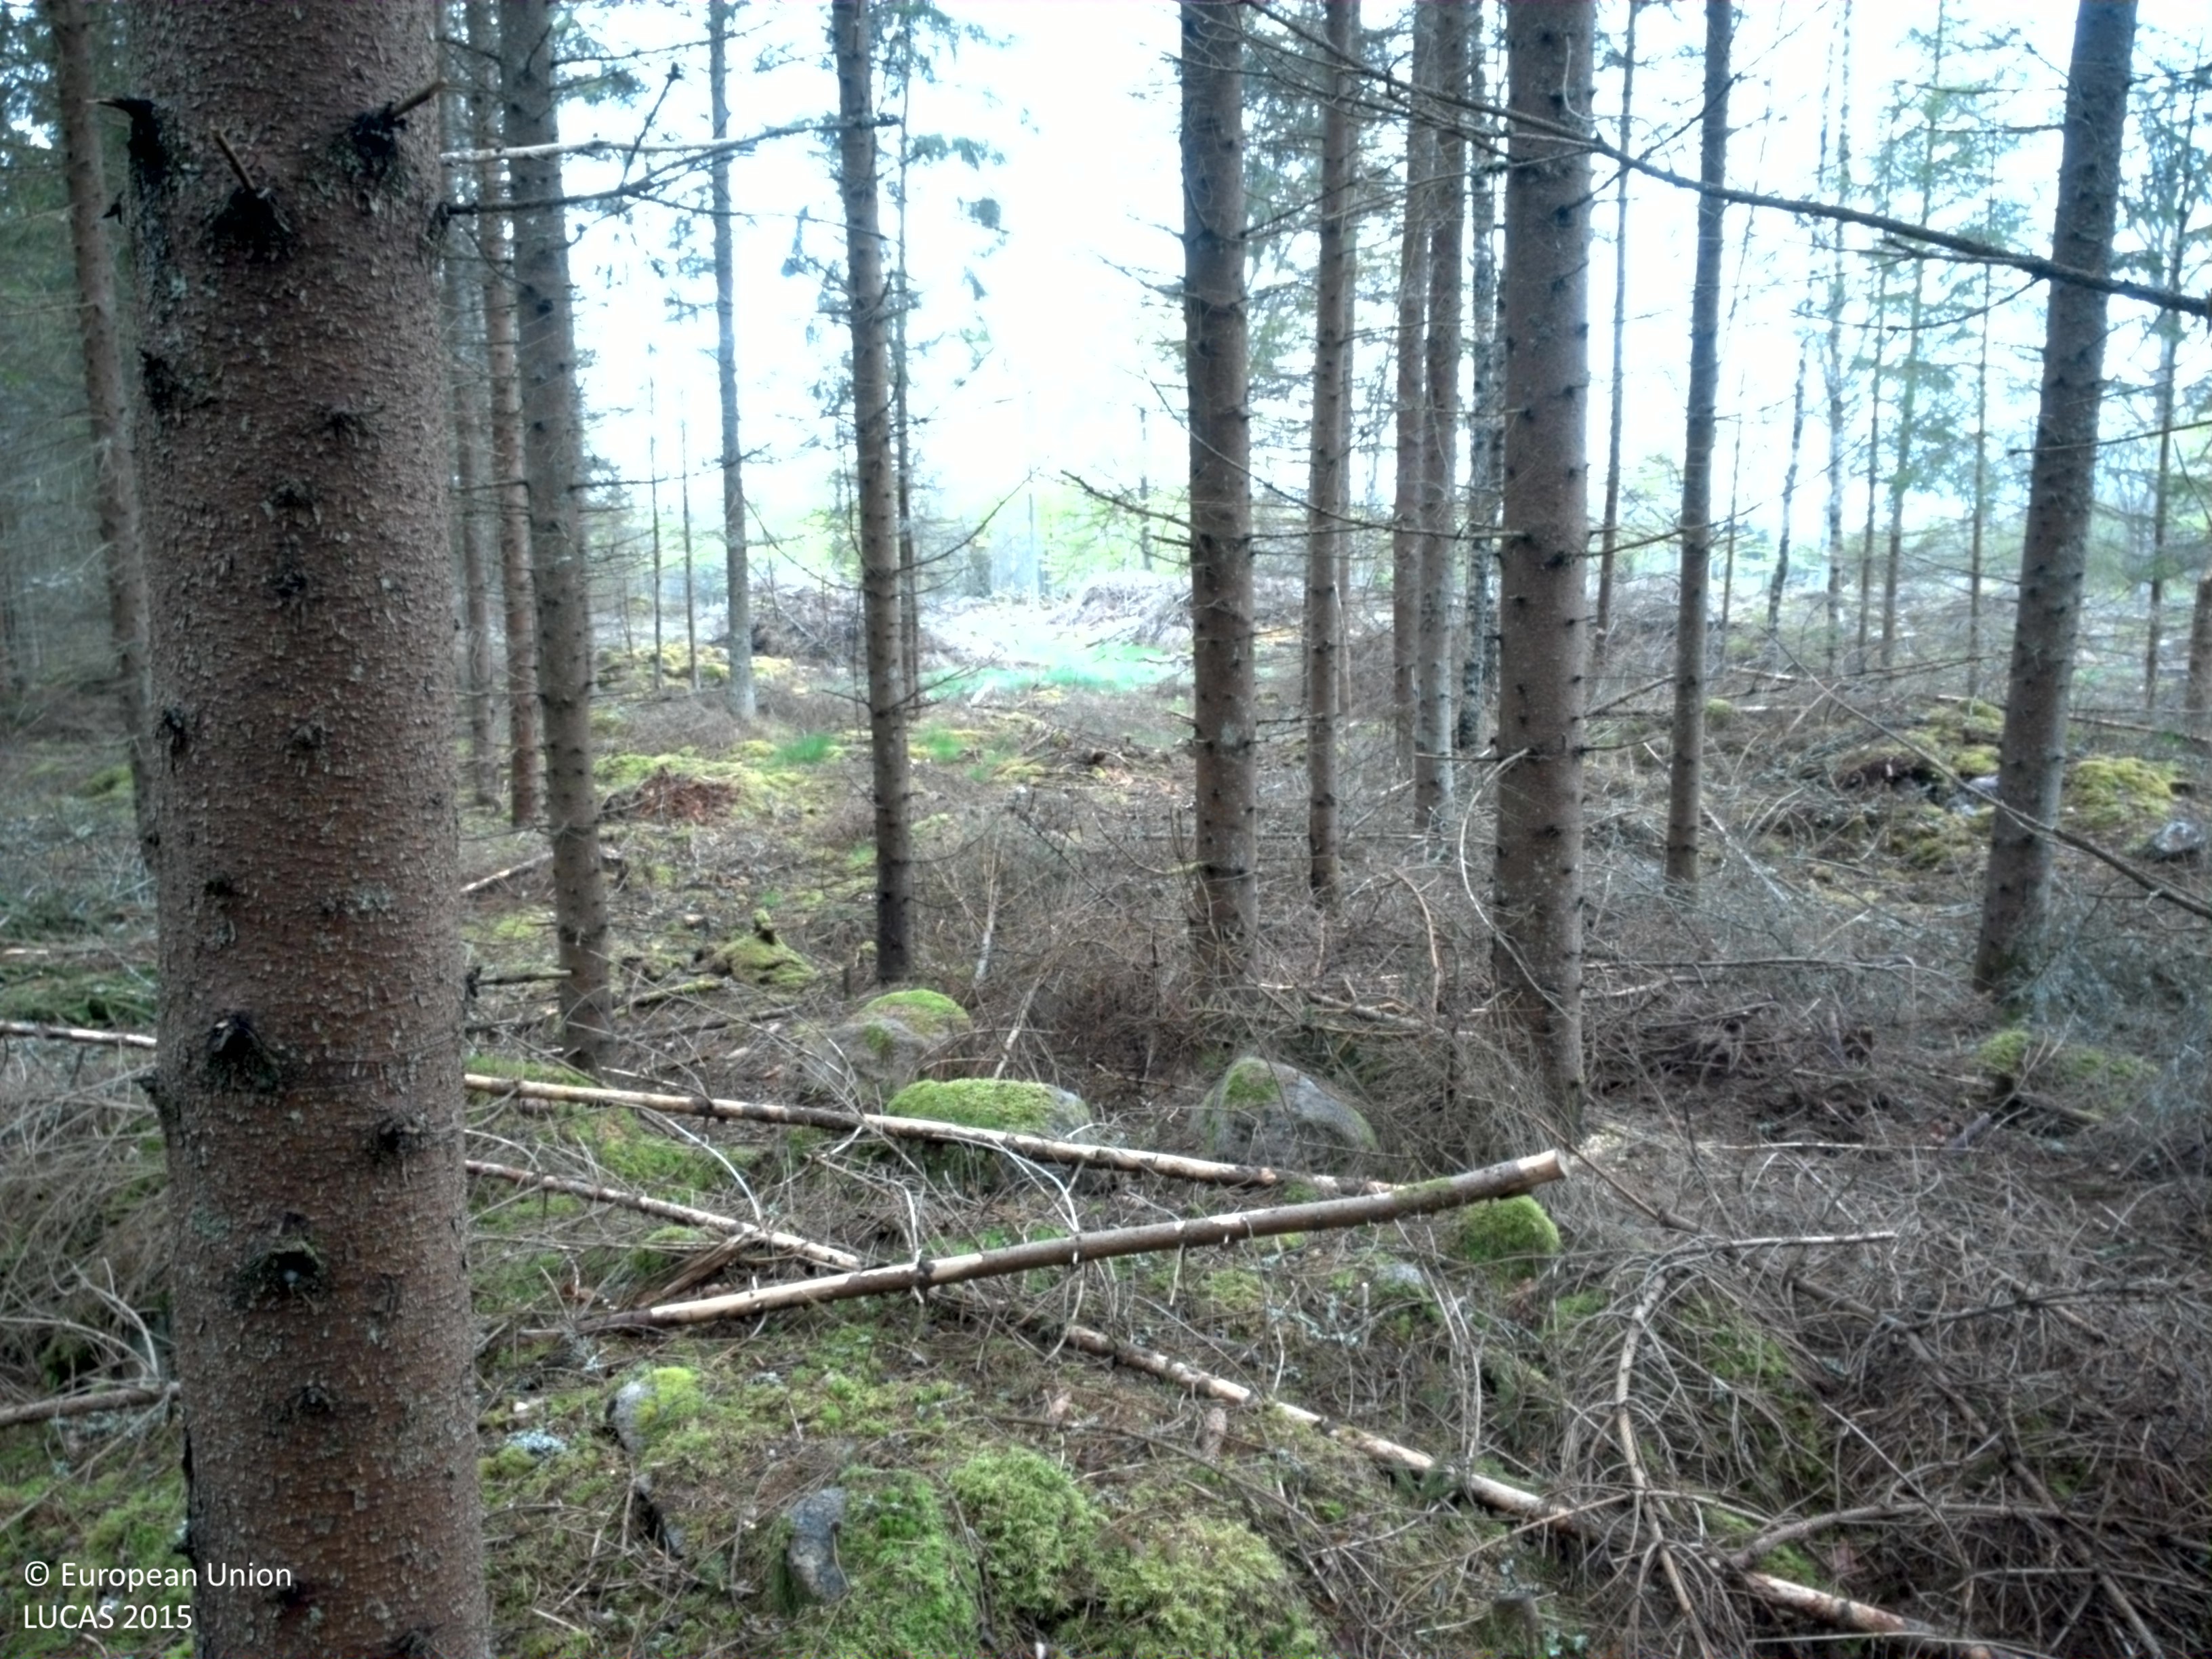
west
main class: Woodland
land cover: Spruce dominated coniferous woodland
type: boreal forest
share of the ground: > 75 %
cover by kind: coniferous forest trees 70 %, lichens and mosses 20 %, broadleaved forest trees 10 %
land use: Forestry
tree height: > 5 m
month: May
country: SE
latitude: 56.6103
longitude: 15.0650
